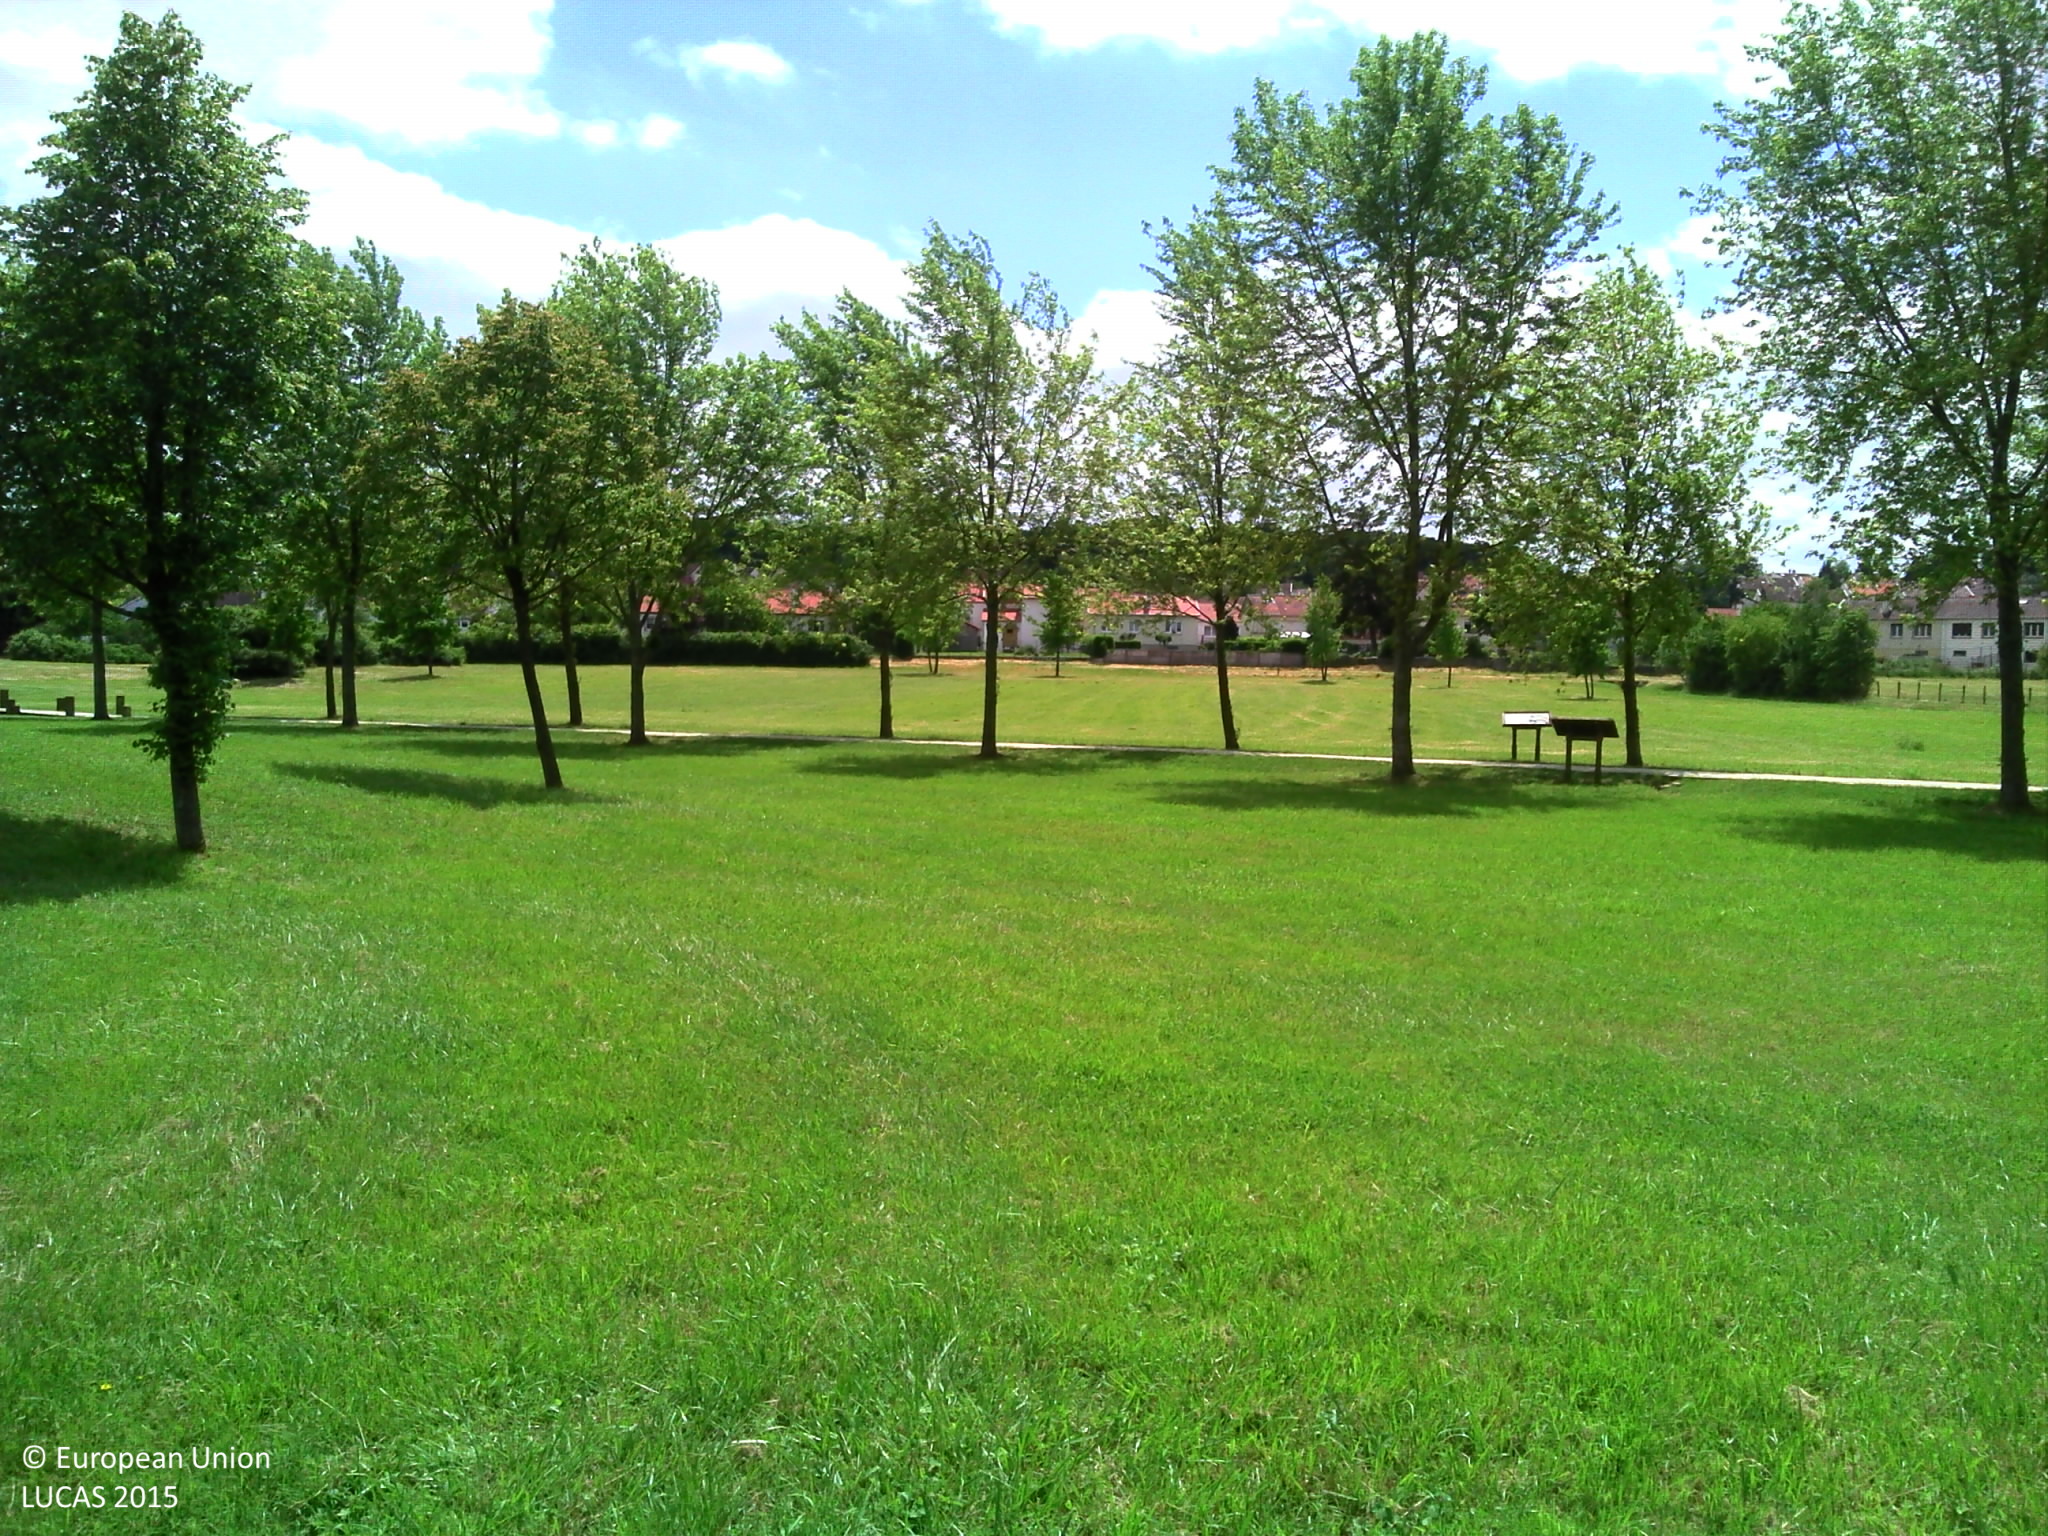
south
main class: Grassland
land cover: Grassland with sparse tree/shrub cover
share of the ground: > 75 %
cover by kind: herbaceous plants 95 %, broadleaved forest trees 5 %
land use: Amenities, museums, leisure
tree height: < 5 m
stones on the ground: < 10 %
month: June
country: FR
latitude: 48.6817
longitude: 6.2378
